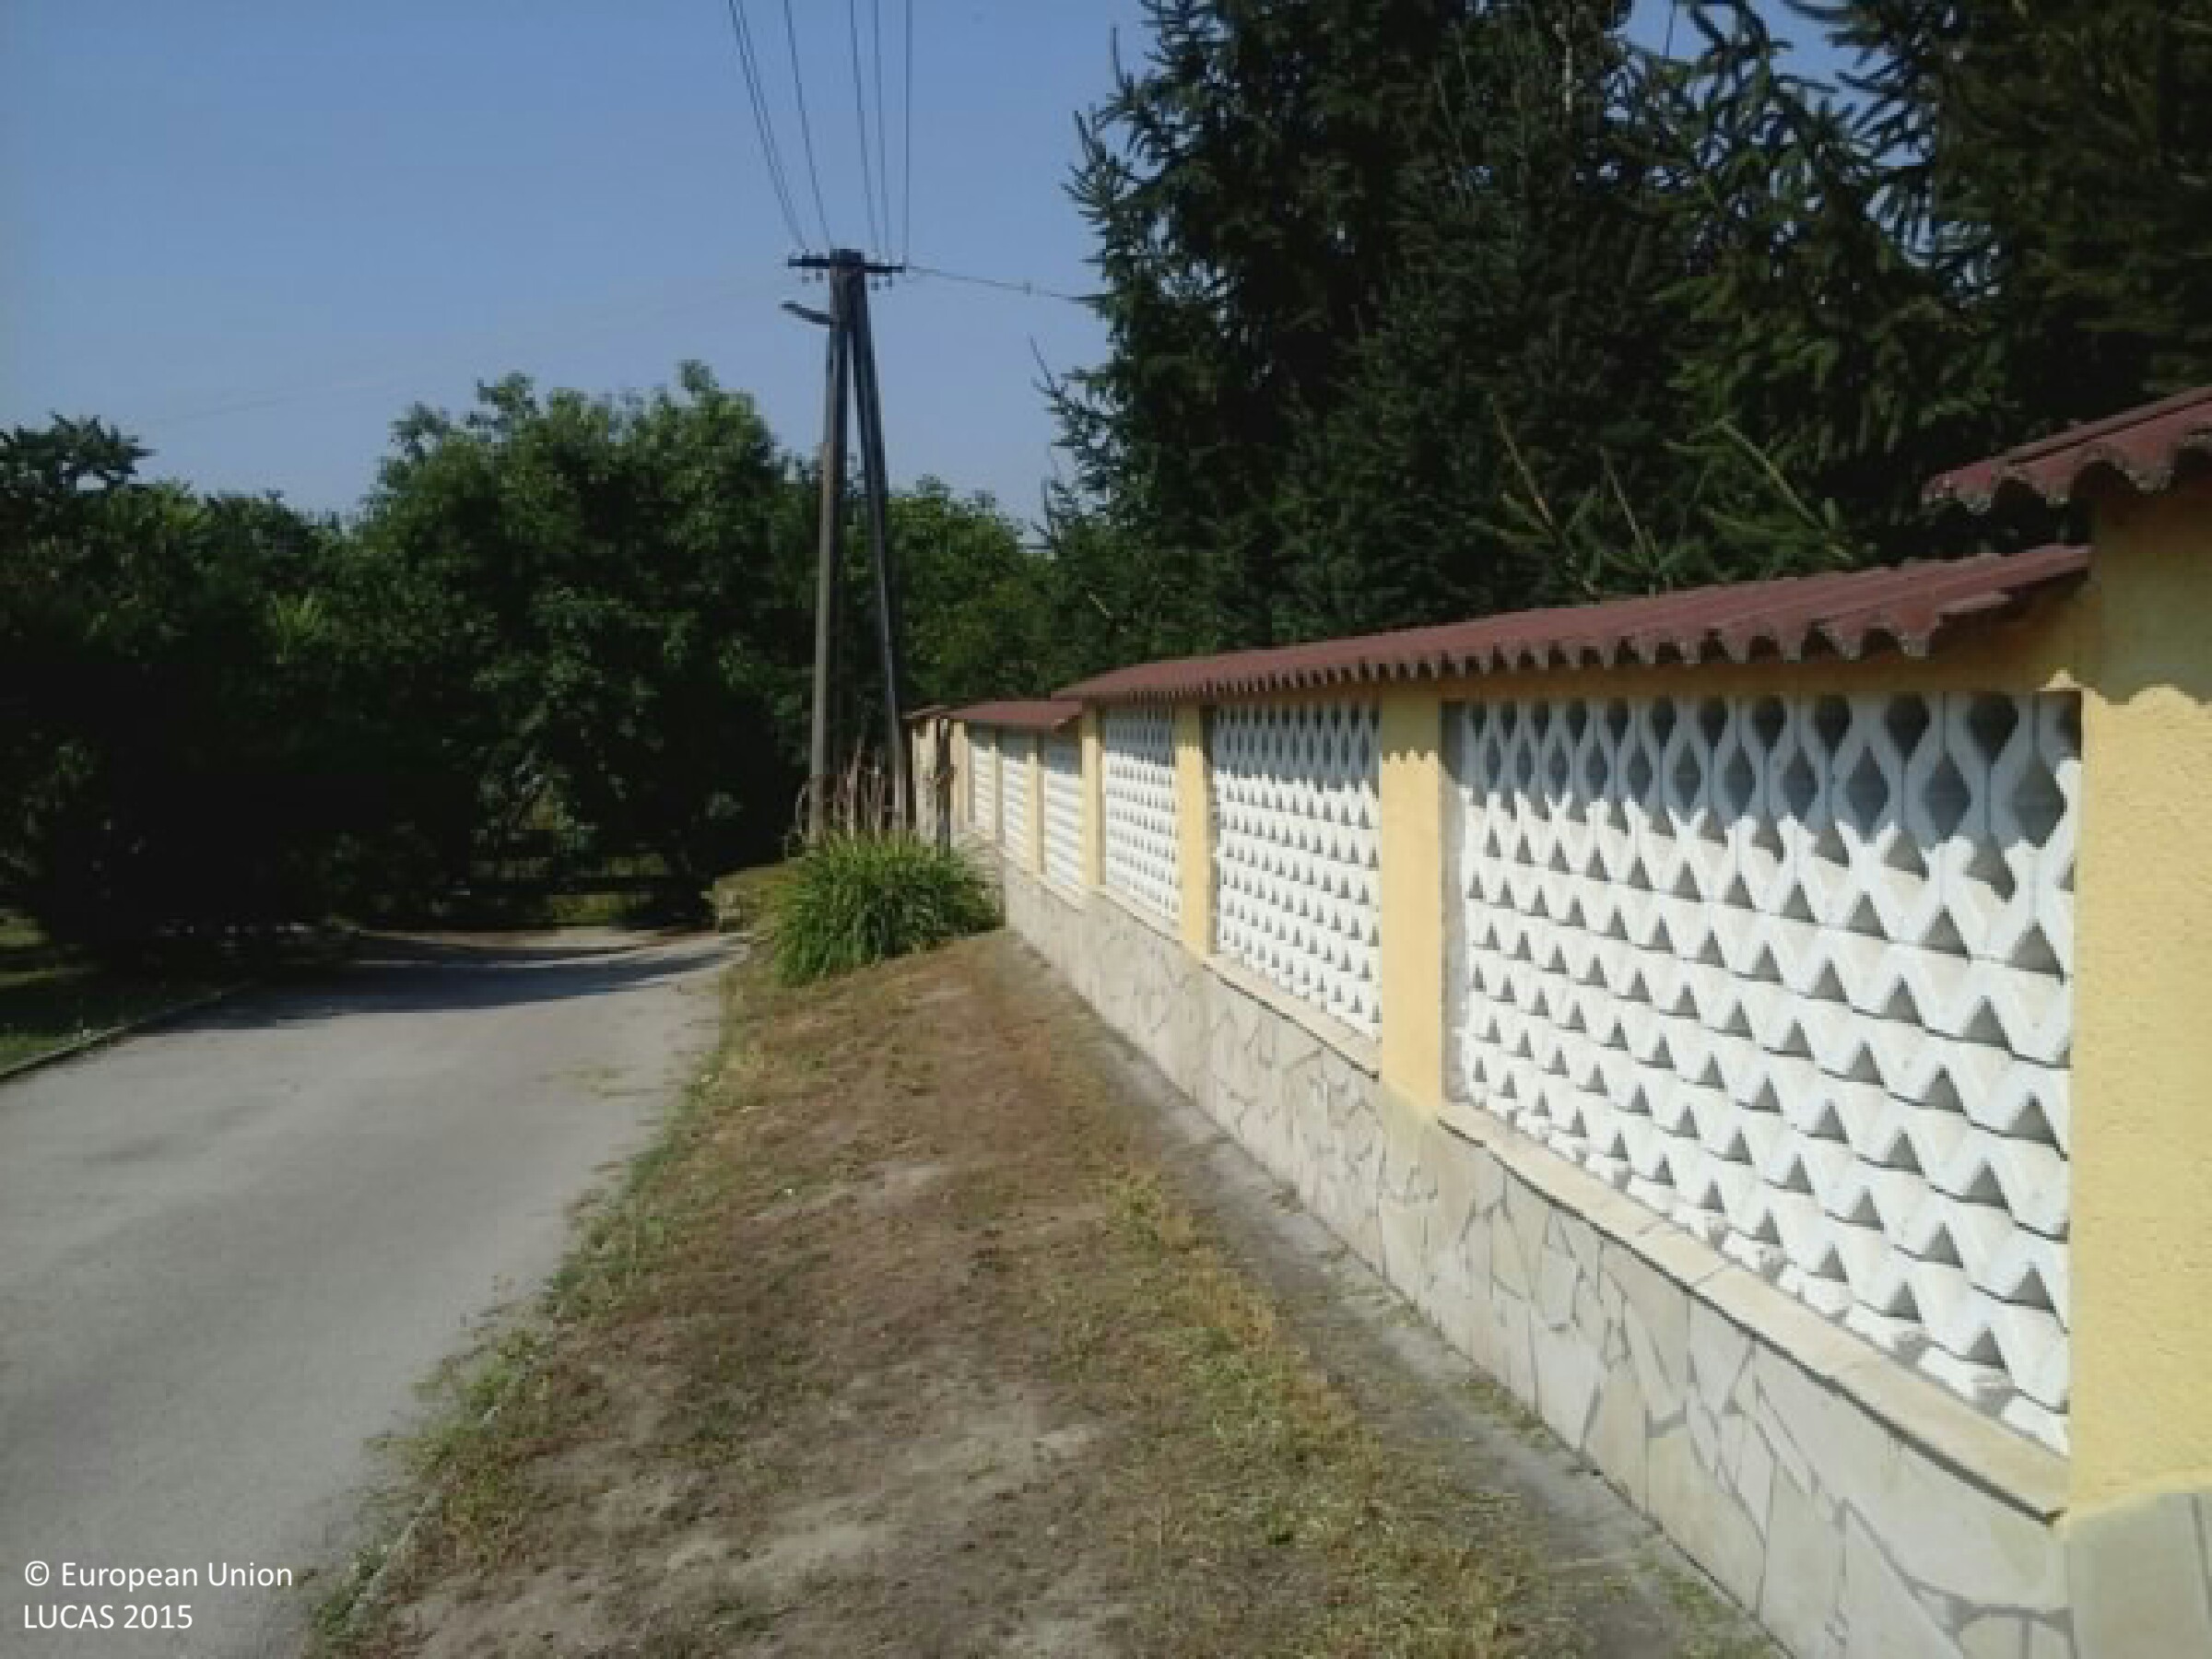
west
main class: Grassland
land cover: Grassland with sparse tree/shrub cover
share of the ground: > 75 %
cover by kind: herbaceous plants 85 %, shrubs 10 %, broadleaved forest trees 5 %
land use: Residential
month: August
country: HU
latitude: 46.9011
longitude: 18.9279
